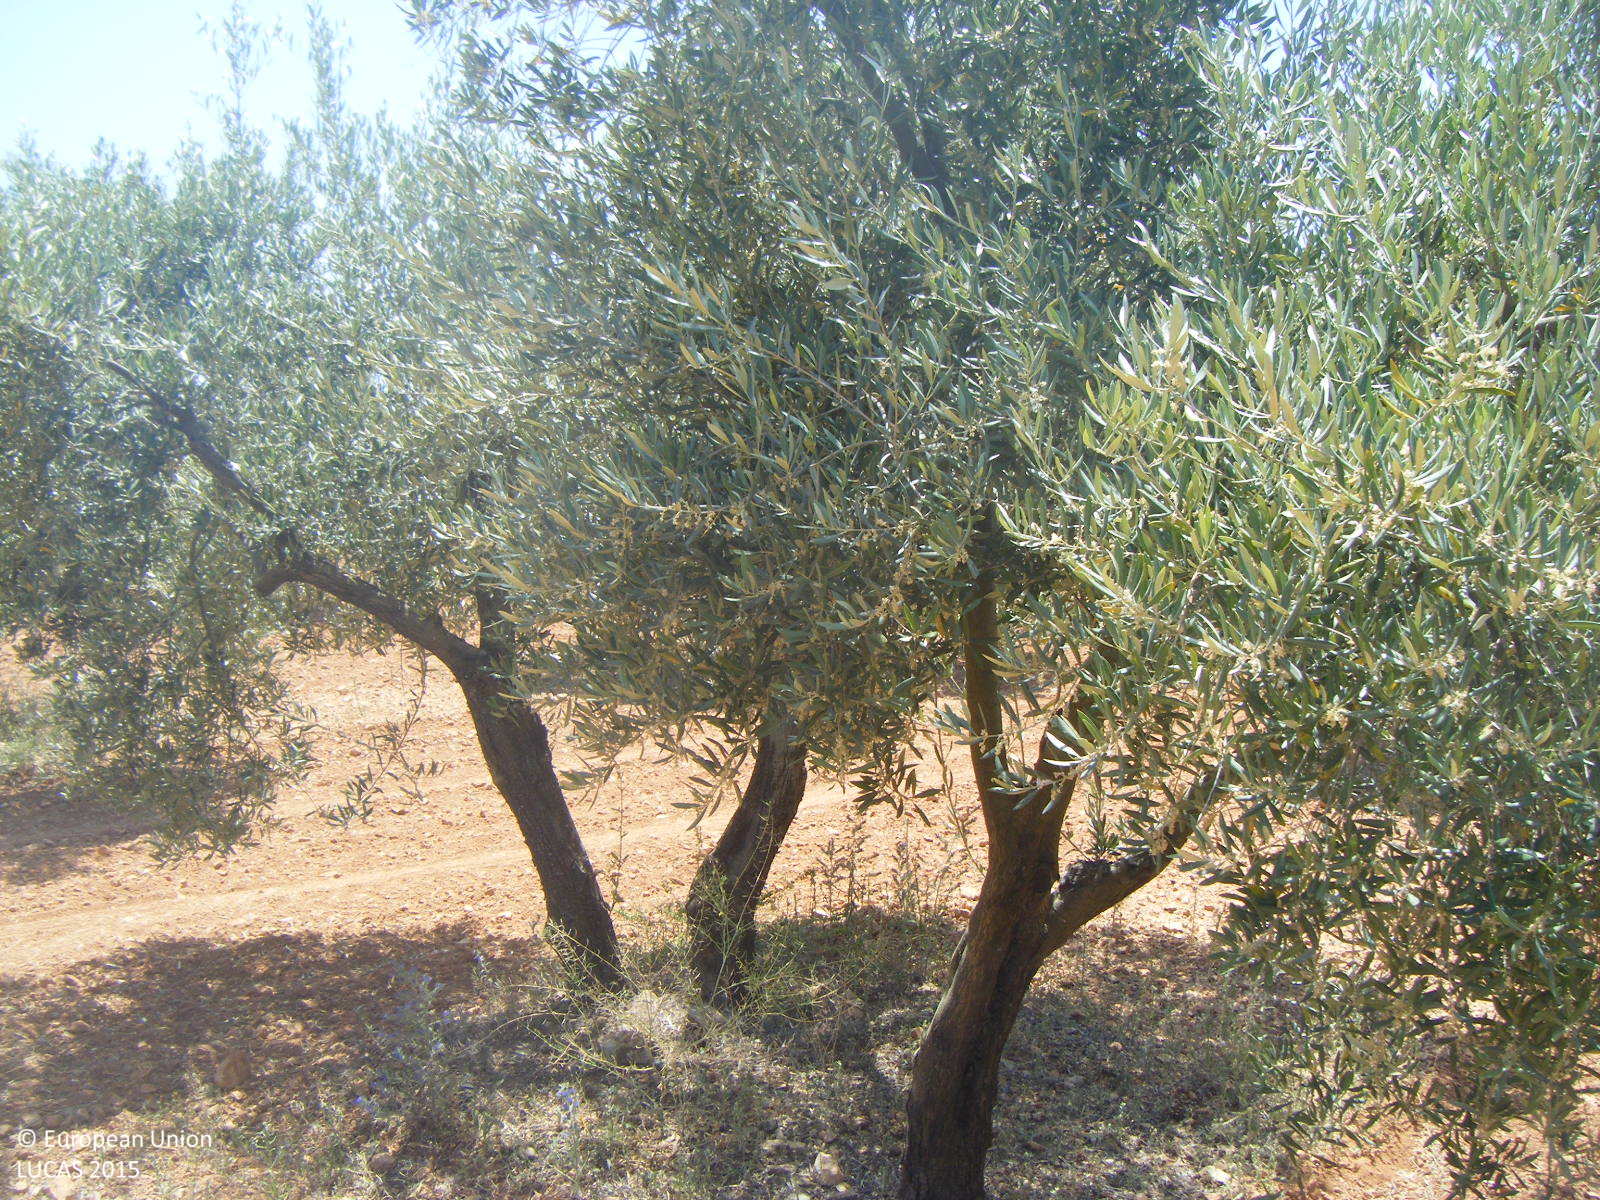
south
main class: Cropland
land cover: Olive groves
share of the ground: 25 - 50 %
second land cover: Other bare soil
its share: > 75 %
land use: Agriculture (excluding fallow land and kitchen gardens)
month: May
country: ES
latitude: 37.2653
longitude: -4.7871
